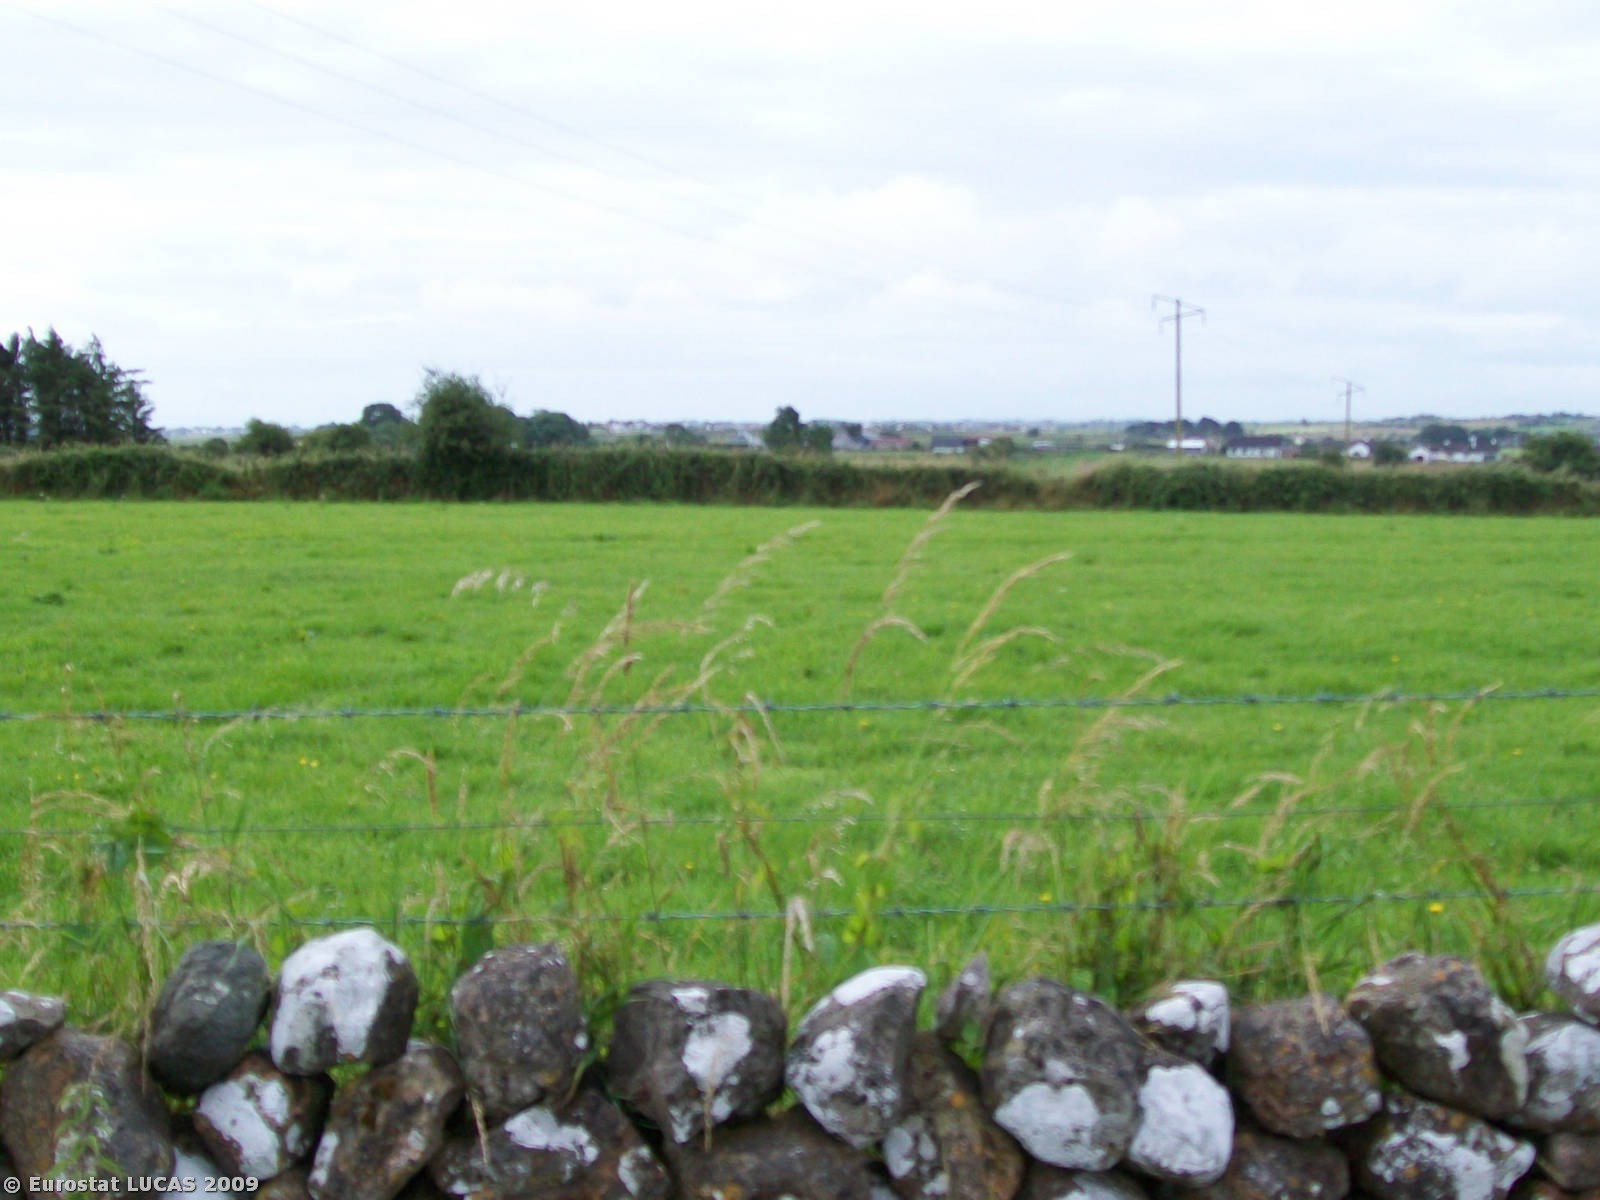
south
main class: Grassland
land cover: Grassland without tree/shrub cover
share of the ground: > 75 %
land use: Agriculture (excluding fallow land and kitchen gardens)
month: July
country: IE
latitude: 53.5046
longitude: -8.8885
